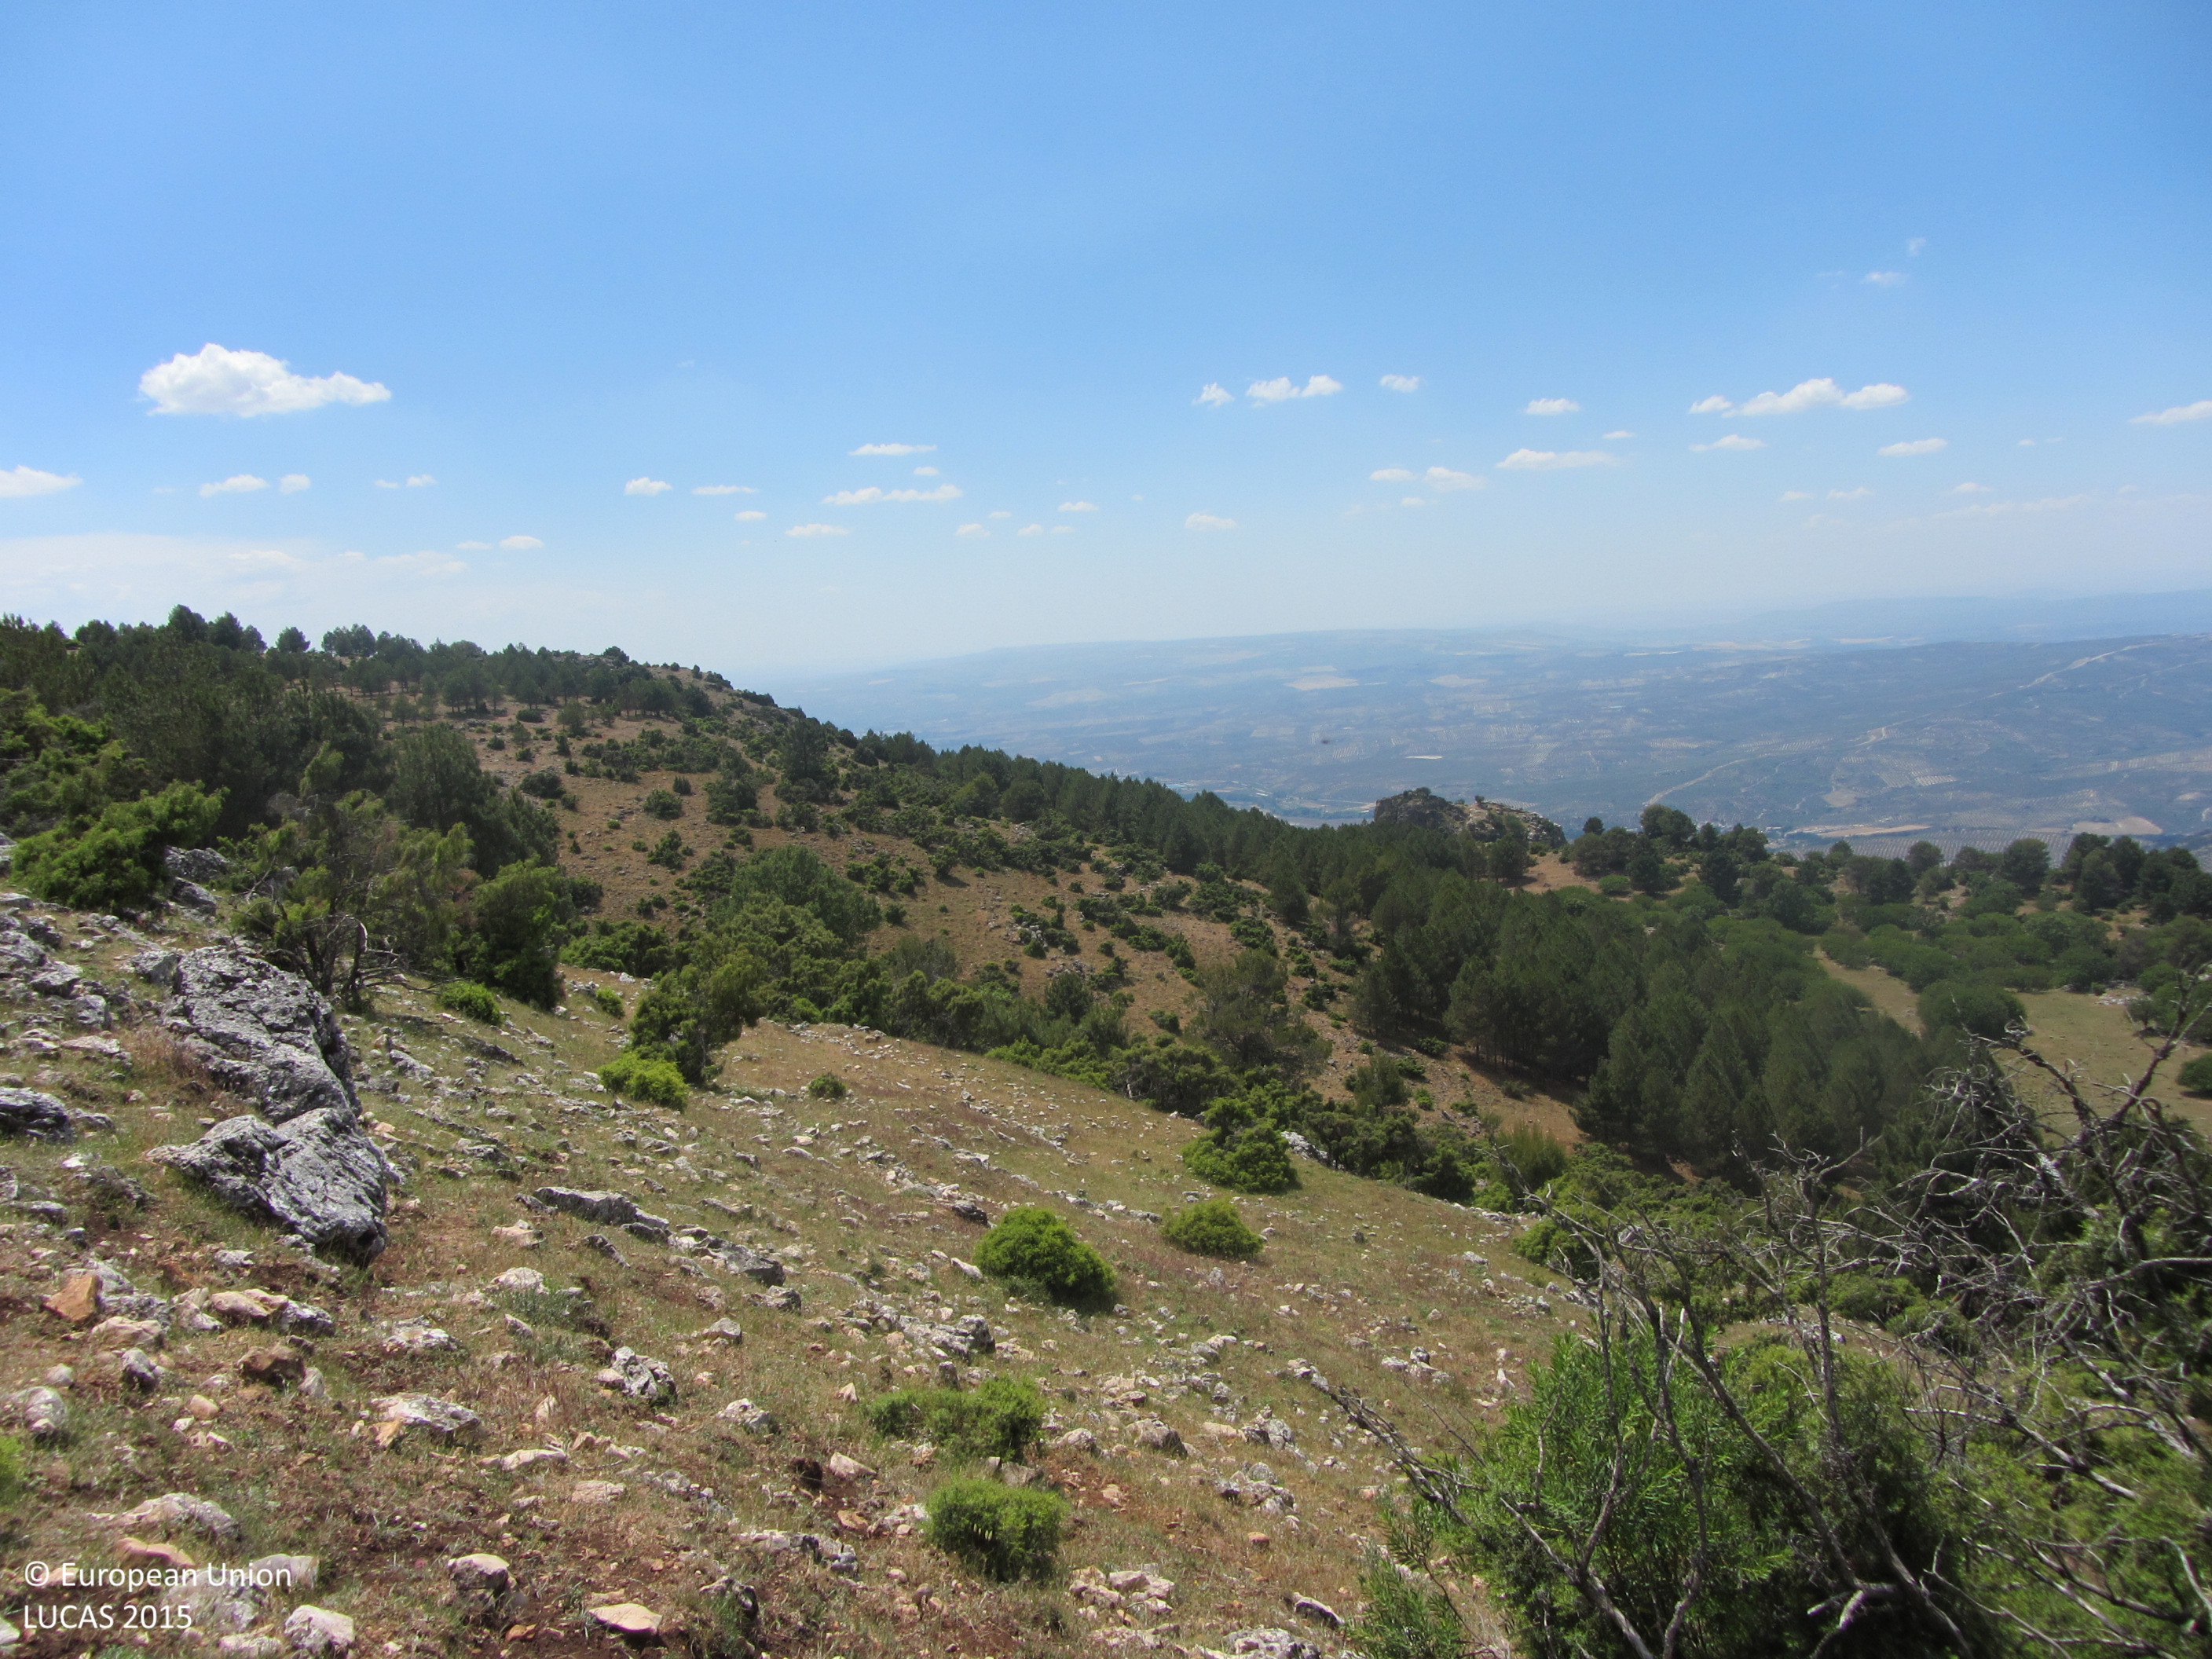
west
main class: Woodland
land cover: Pine dominated coniferous woodland
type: coniferous forest of the mediterranean region
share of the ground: 10 - 25 %
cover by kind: herbaceous plants 75 %, coniferous forest trees 15 %, consolidated bare surface 10 %
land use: Semi-natural and natural areas not in use
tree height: > 5 m
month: May
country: ES
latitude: 38.0672
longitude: -2.9569
